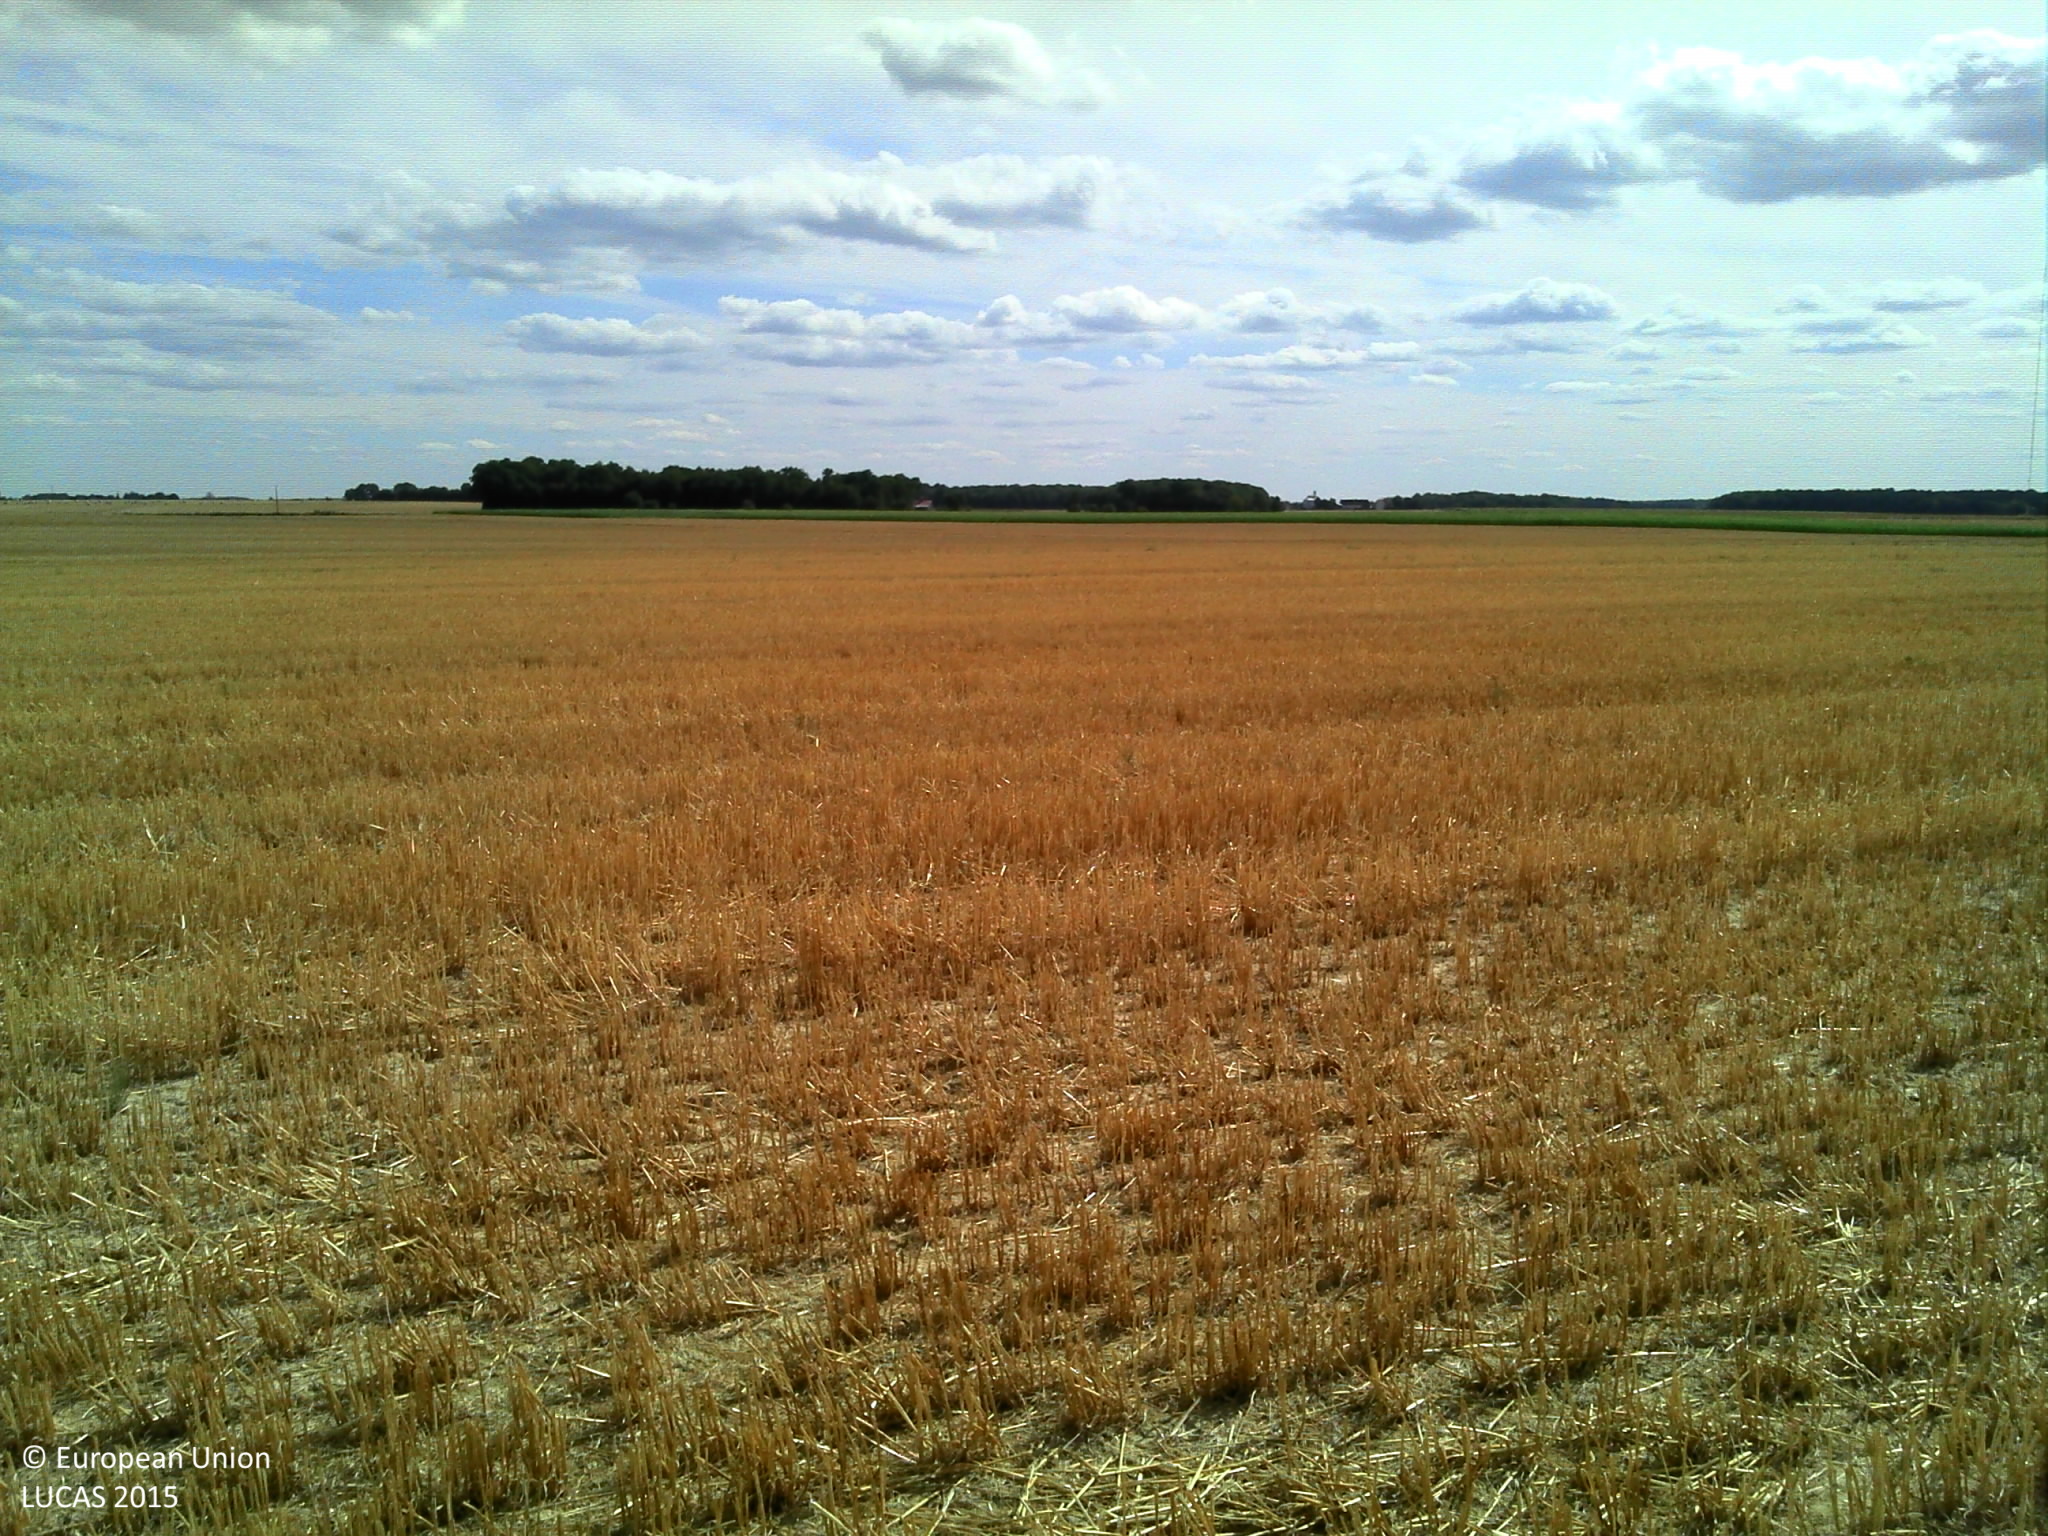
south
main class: Cropland
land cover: Barley
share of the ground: > 75 %
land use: Agriculture (excluding fallow land and kitchen gardens)
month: July
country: FR
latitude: 47.8063
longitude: 3.0636
